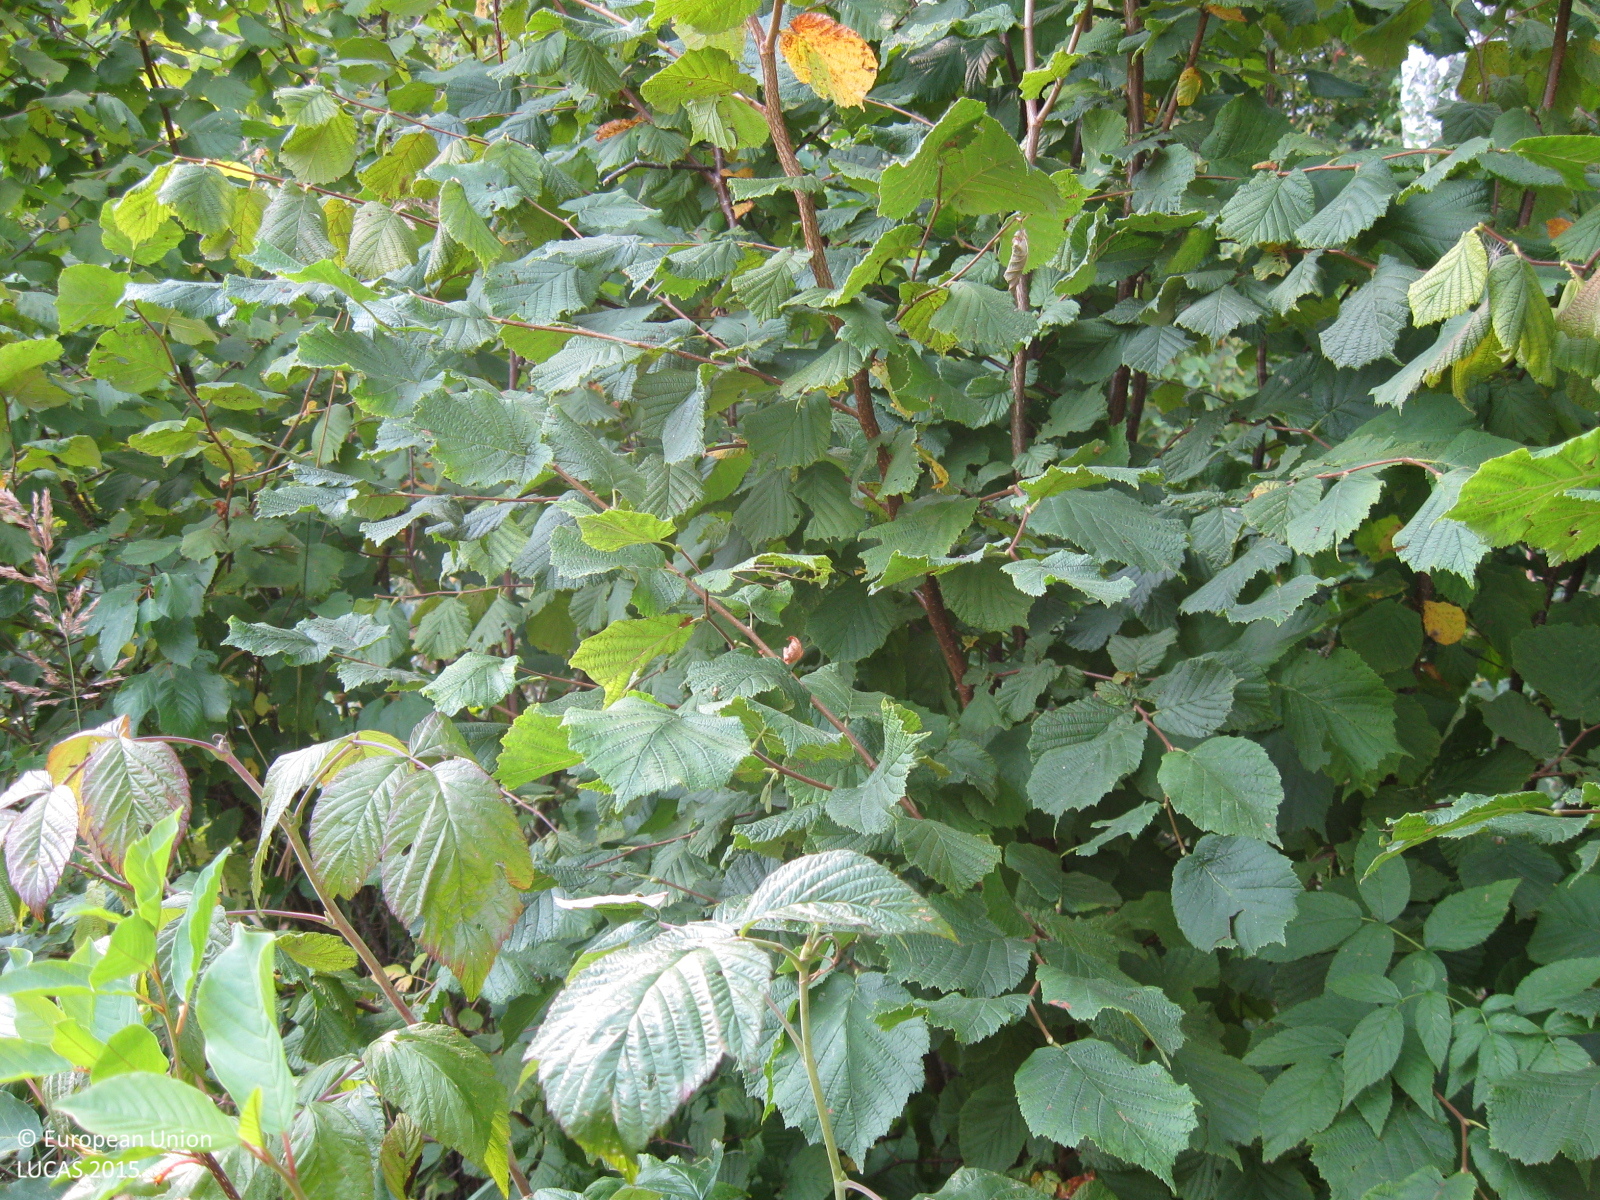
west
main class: Woodland
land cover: Broadleaved woodland
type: non-riverine alder, birch or aspen forest
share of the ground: > 75 %
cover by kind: broadleaved forest trees 85 %, herbaceous plants 10 %, unconsolidated bare surface 5 %
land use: Forestry
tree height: < 5 m
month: August
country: LT
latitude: 55.1464
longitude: 23.1114
